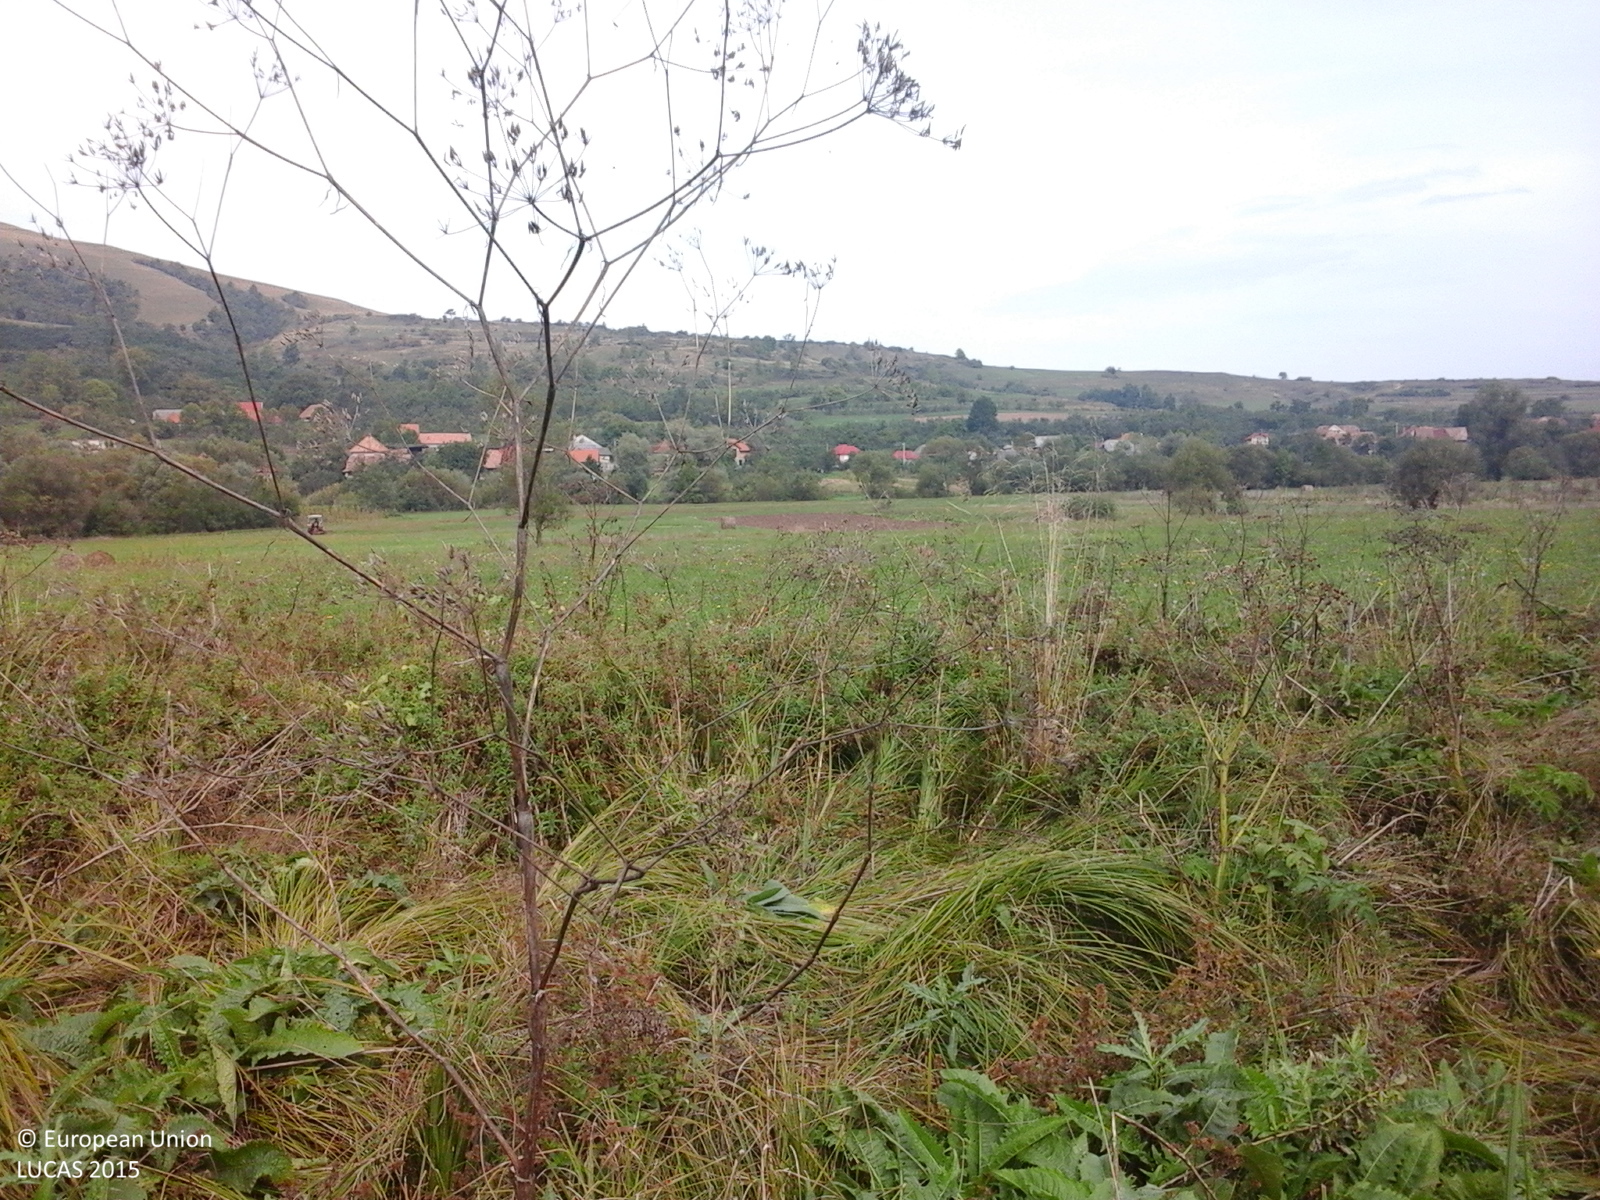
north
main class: Grassland
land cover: Spontaneously vegetated surfaces
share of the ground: > 75 %
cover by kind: herbaceous plants 100 %
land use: Fallow land
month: September
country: RO
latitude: 46.8571
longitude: 22.9273
